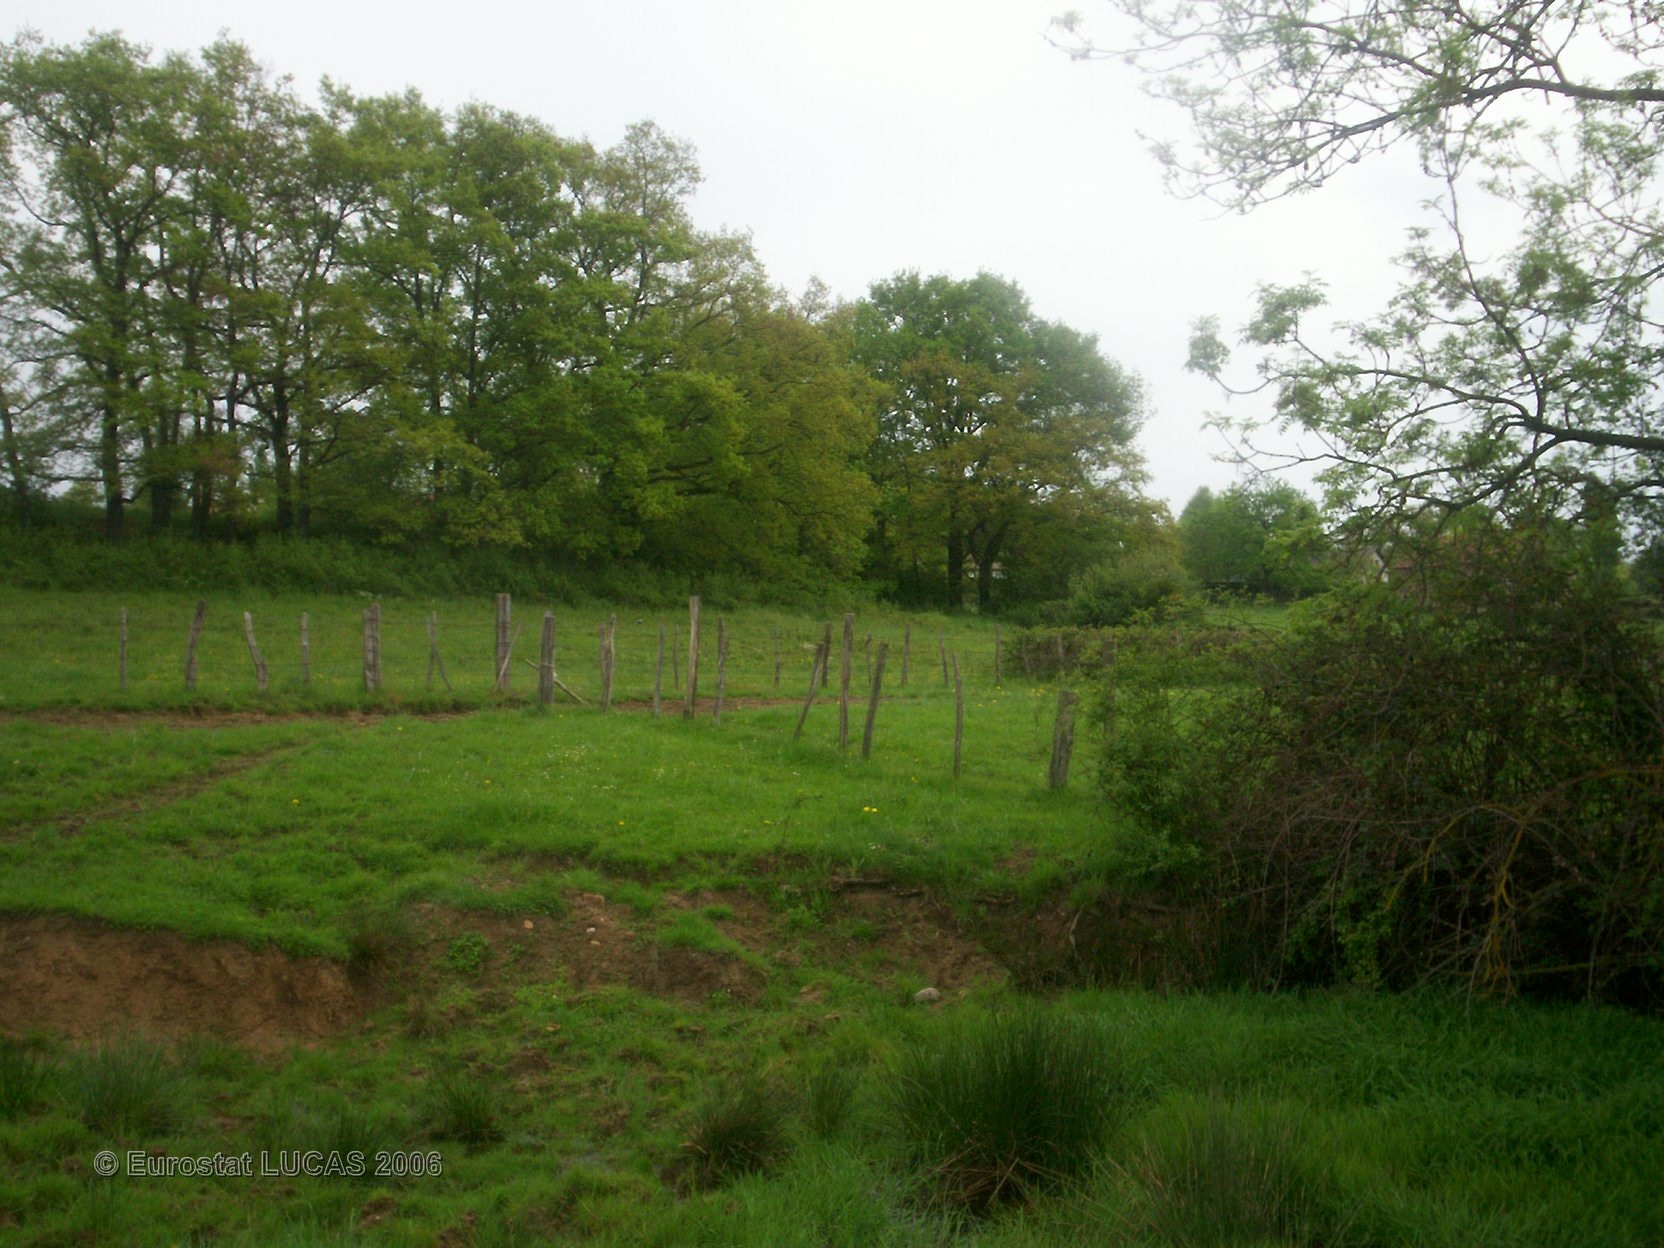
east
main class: Grassland
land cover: Grassland with sparse tree/shrub cover
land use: Agriculture (excluding fallow land and kitchen gardens)
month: May
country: FR
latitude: 46.0370
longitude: 3.0861
